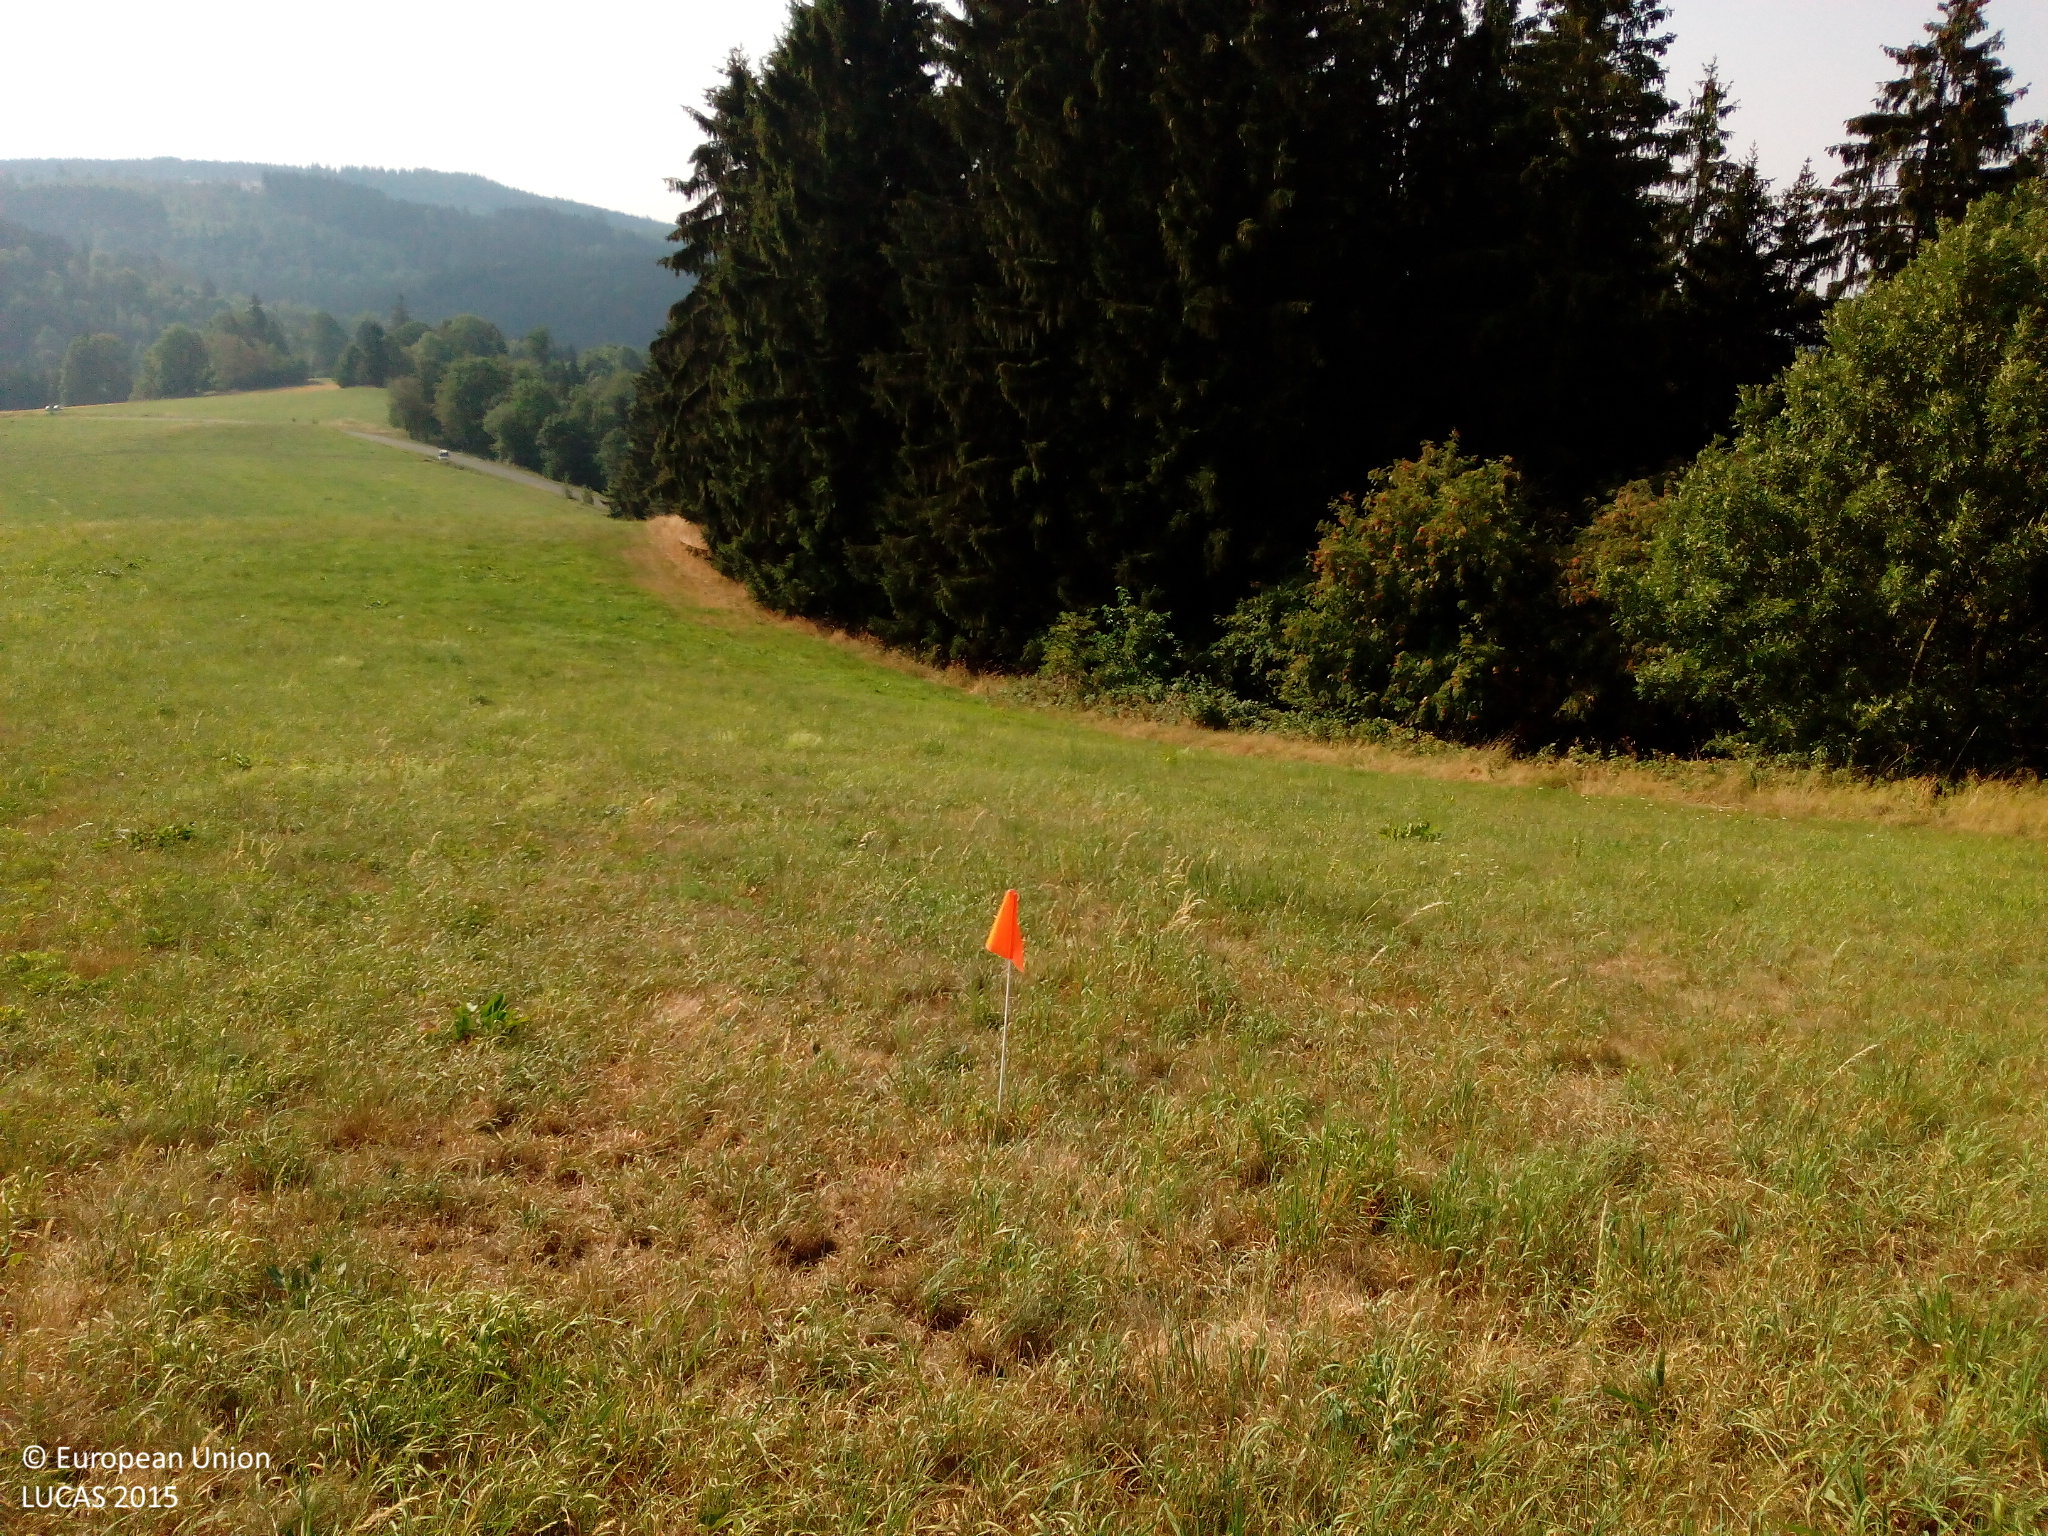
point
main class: Grassland
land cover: Grassland without tree/shrub cover
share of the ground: 25 - 50 %
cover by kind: herbaceous plants 45 %, unconsolidated bare surface 20 %
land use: Agriculture (excluding fallow land and kitchen gardens)
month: August
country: DE
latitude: 50.2272
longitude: 11.5836
